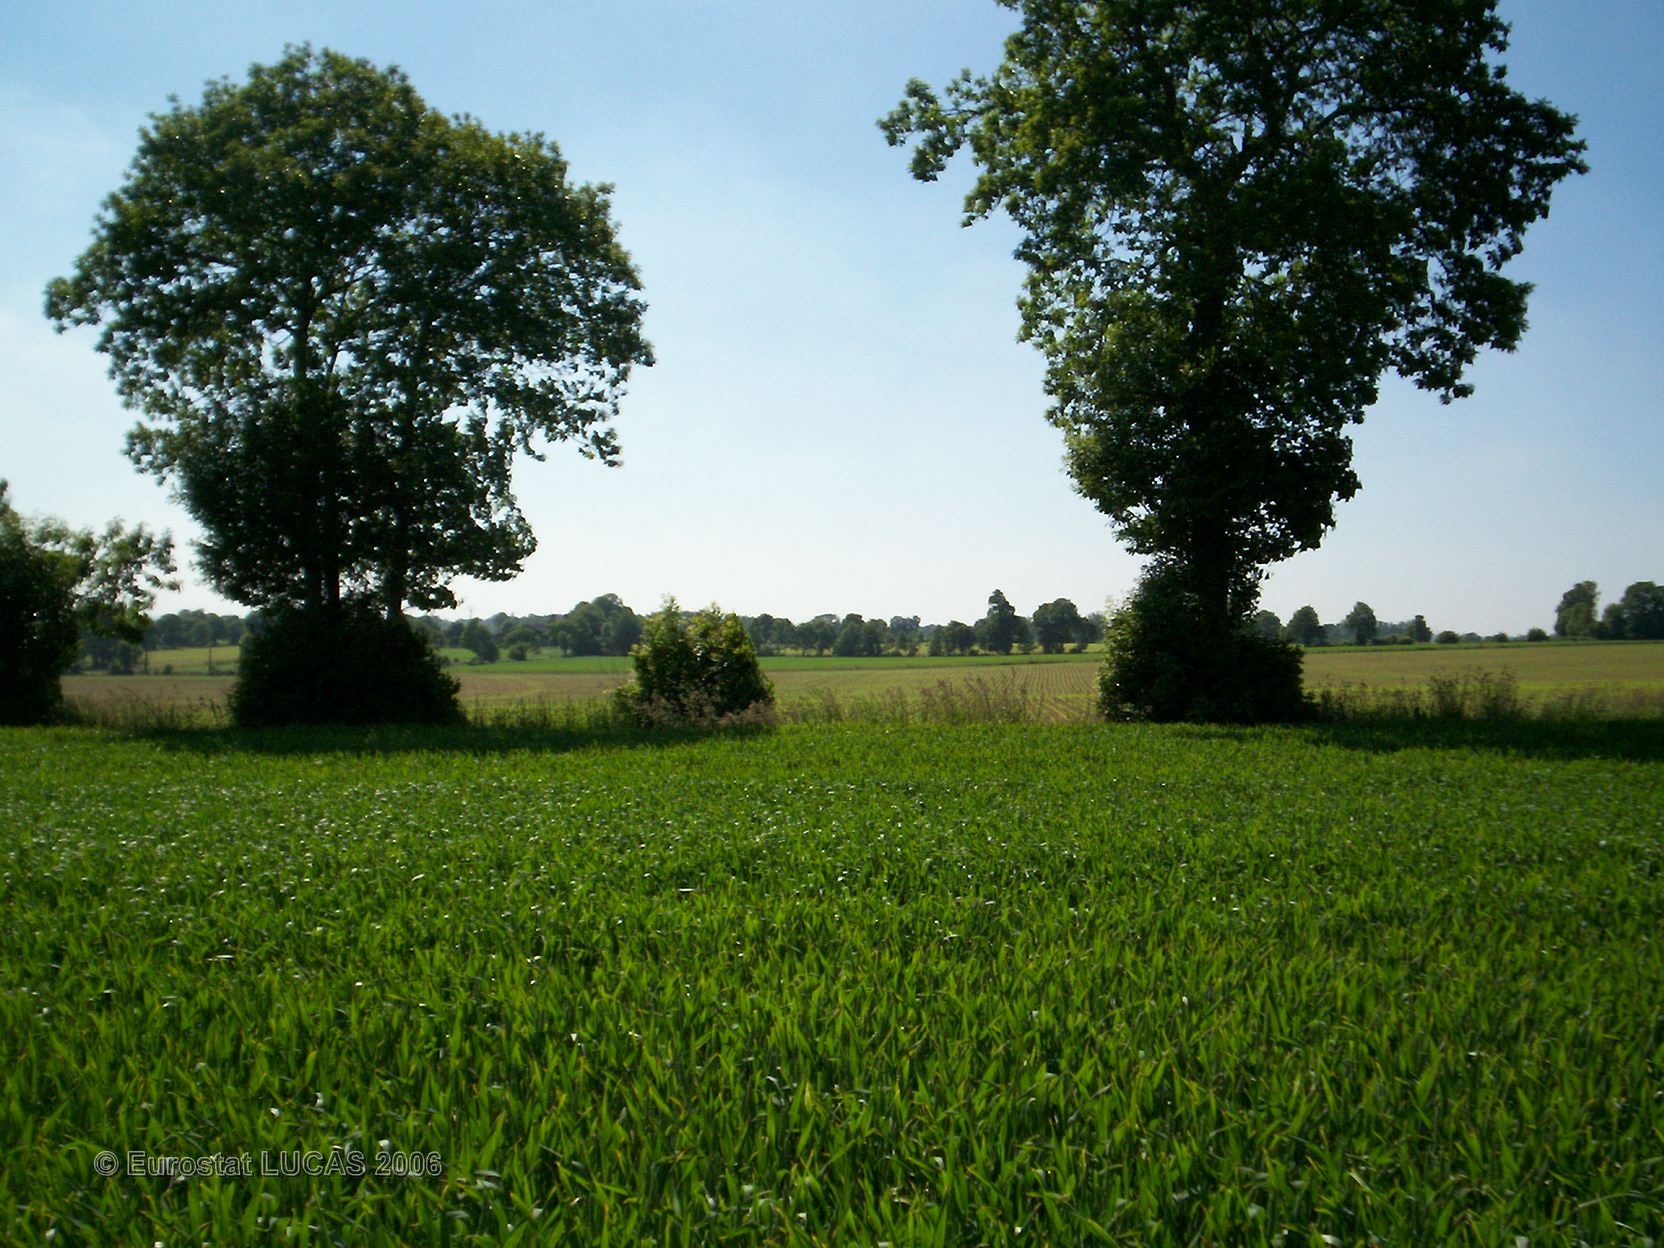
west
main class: Cropland
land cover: Common wheat
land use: Agriculture (excluding fallow land and kitchen gardens)
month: June
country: FR
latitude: 48.4180
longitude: -1.6830
